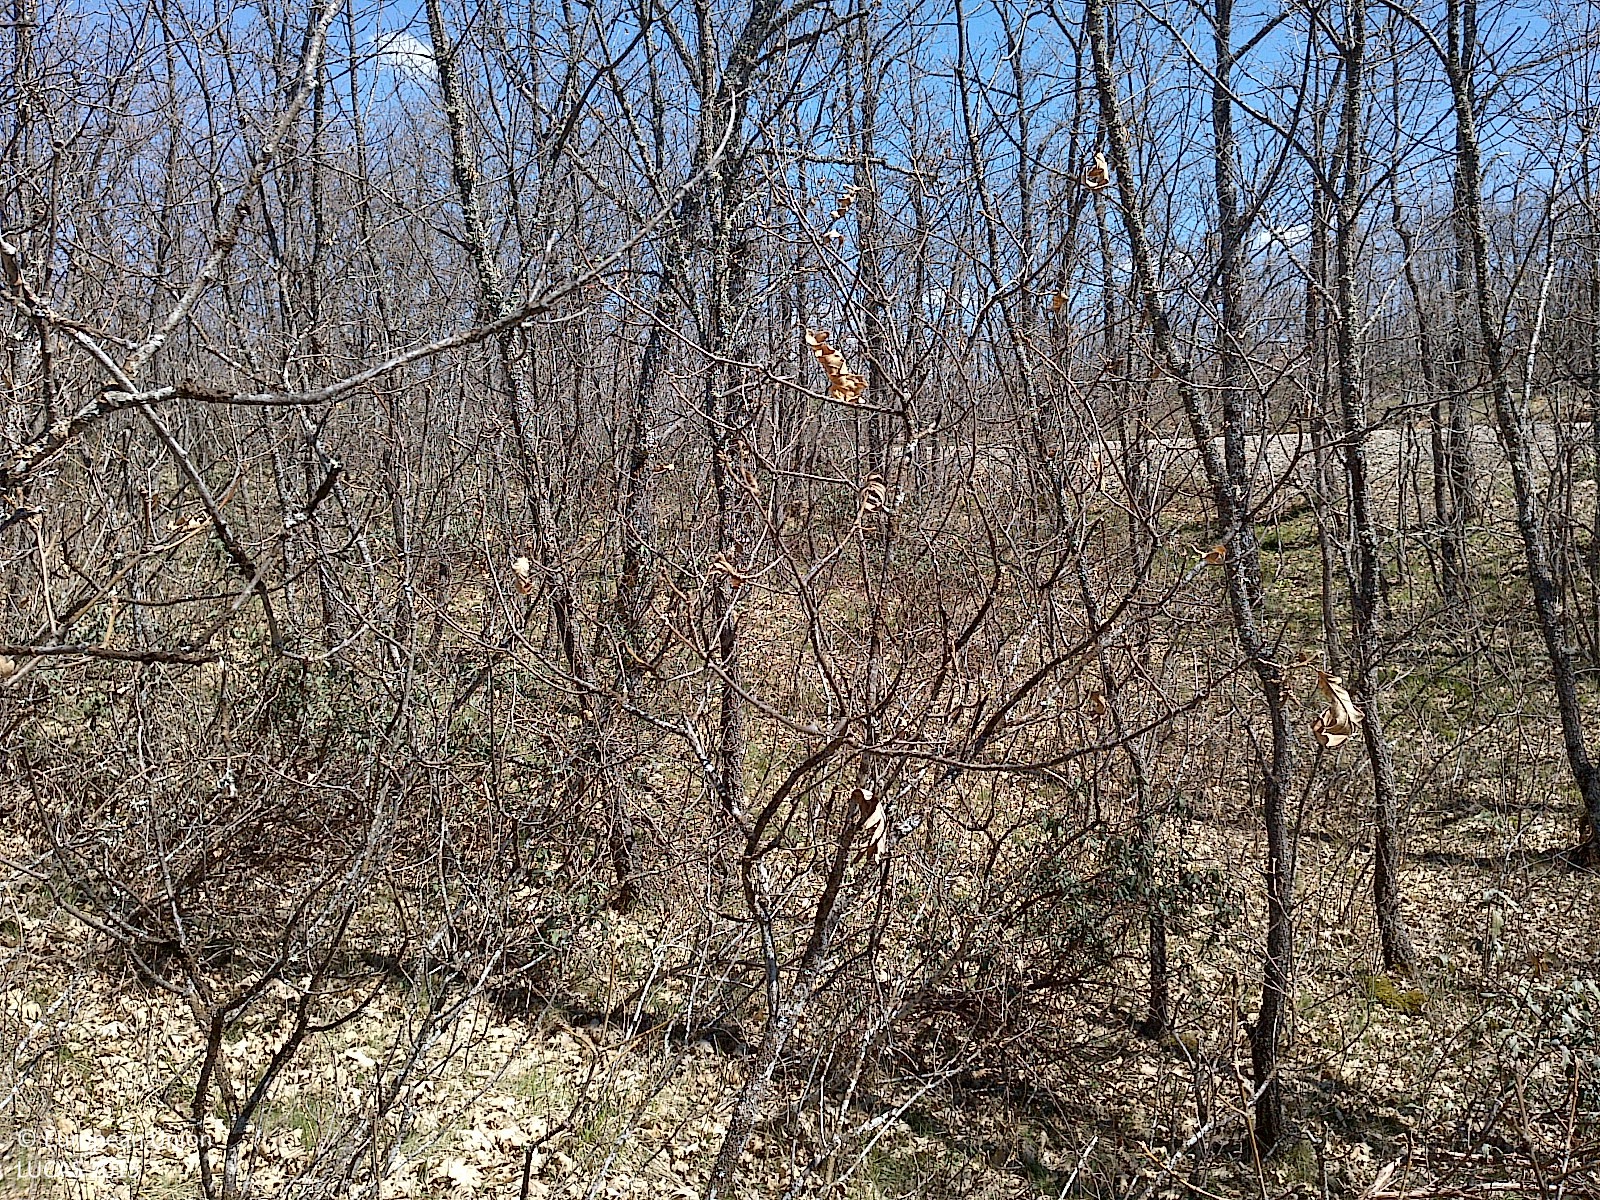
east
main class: Woodland
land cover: Broadleaved woodland
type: thermophilous deciduous forest
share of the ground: > 75 %
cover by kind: broadleaved forest trees 80 %, herbaceous plants 15 %, shrubs 5 %
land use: Forestry
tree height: > 5 m
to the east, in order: Broadleaved woodland; Paved roads, cycling and walking lanes; Broadleaved woodland; Electric lines; Broadleaved woodland; Tracks; Broadleaved woodland
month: April
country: ES
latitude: 42.1025
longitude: -3.2930
